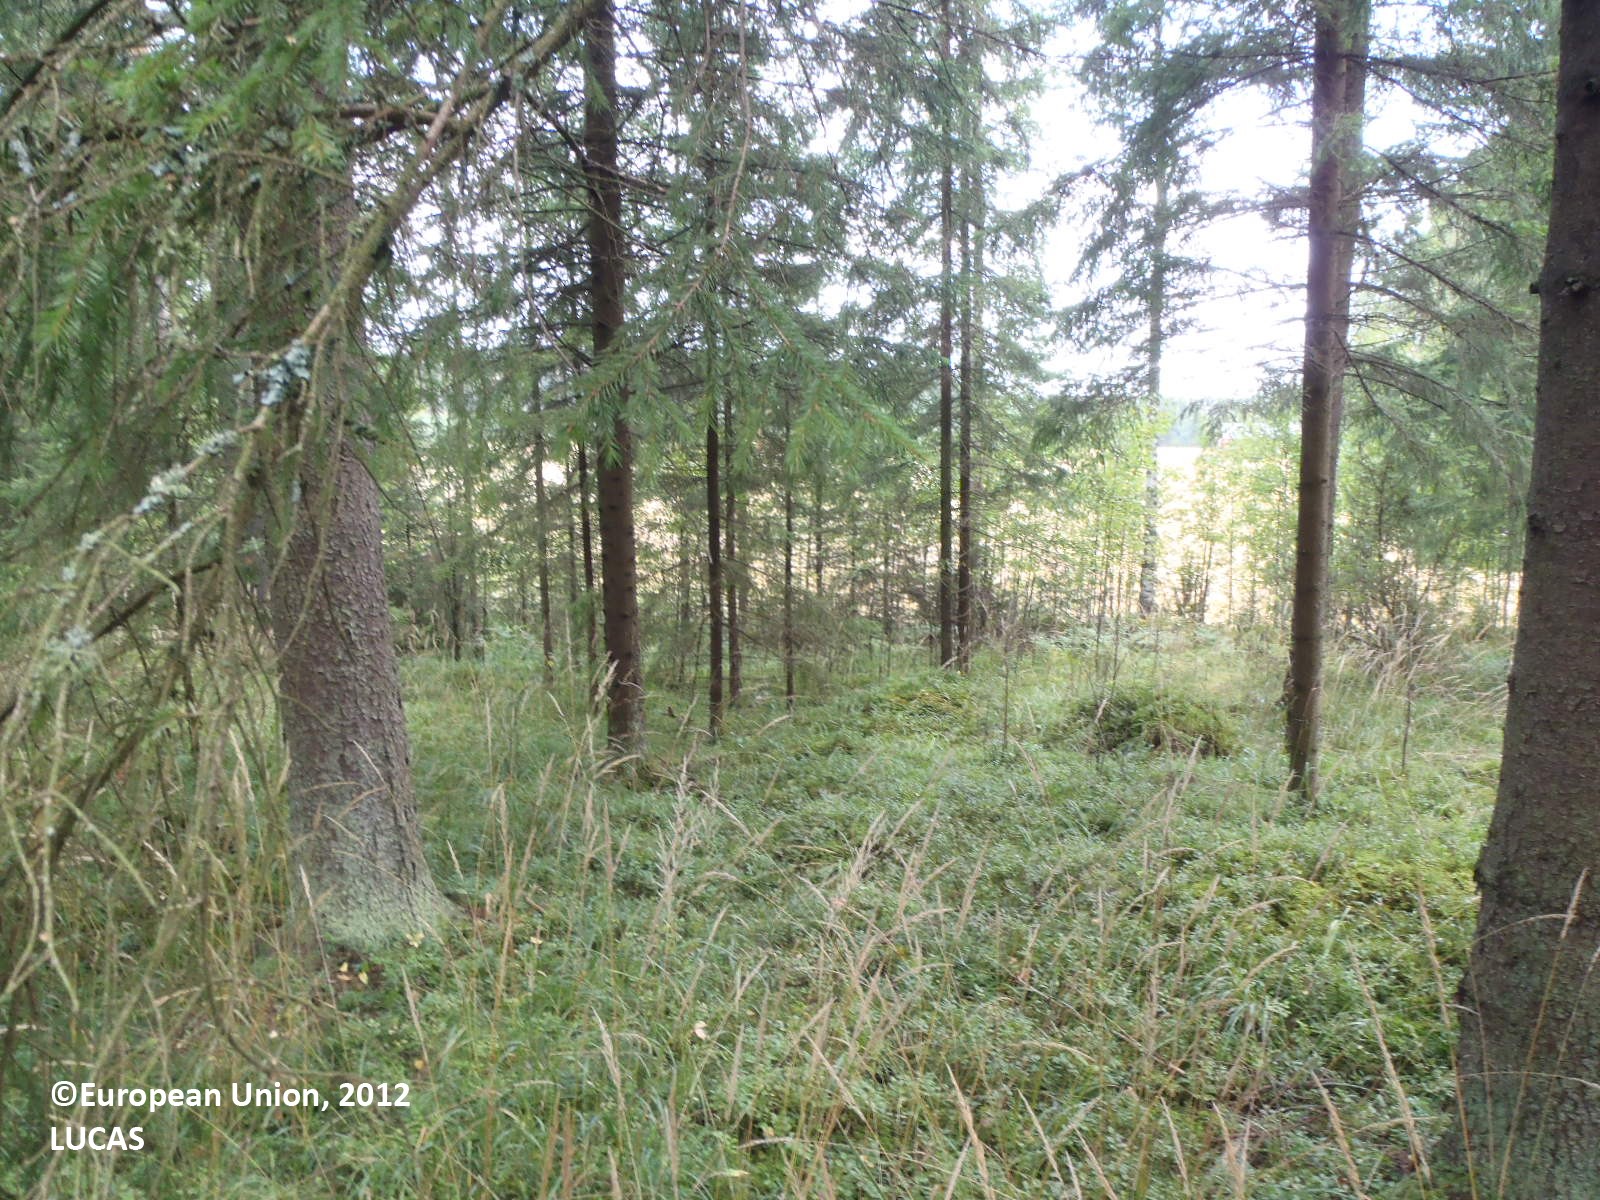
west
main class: Woodland
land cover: Spruce dominated coniferous woodland
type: boreal forest
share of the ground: > 75 %
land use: Forestry
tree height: > 5 m
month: August
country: FI
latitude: 60.8498
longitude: 22.4532
